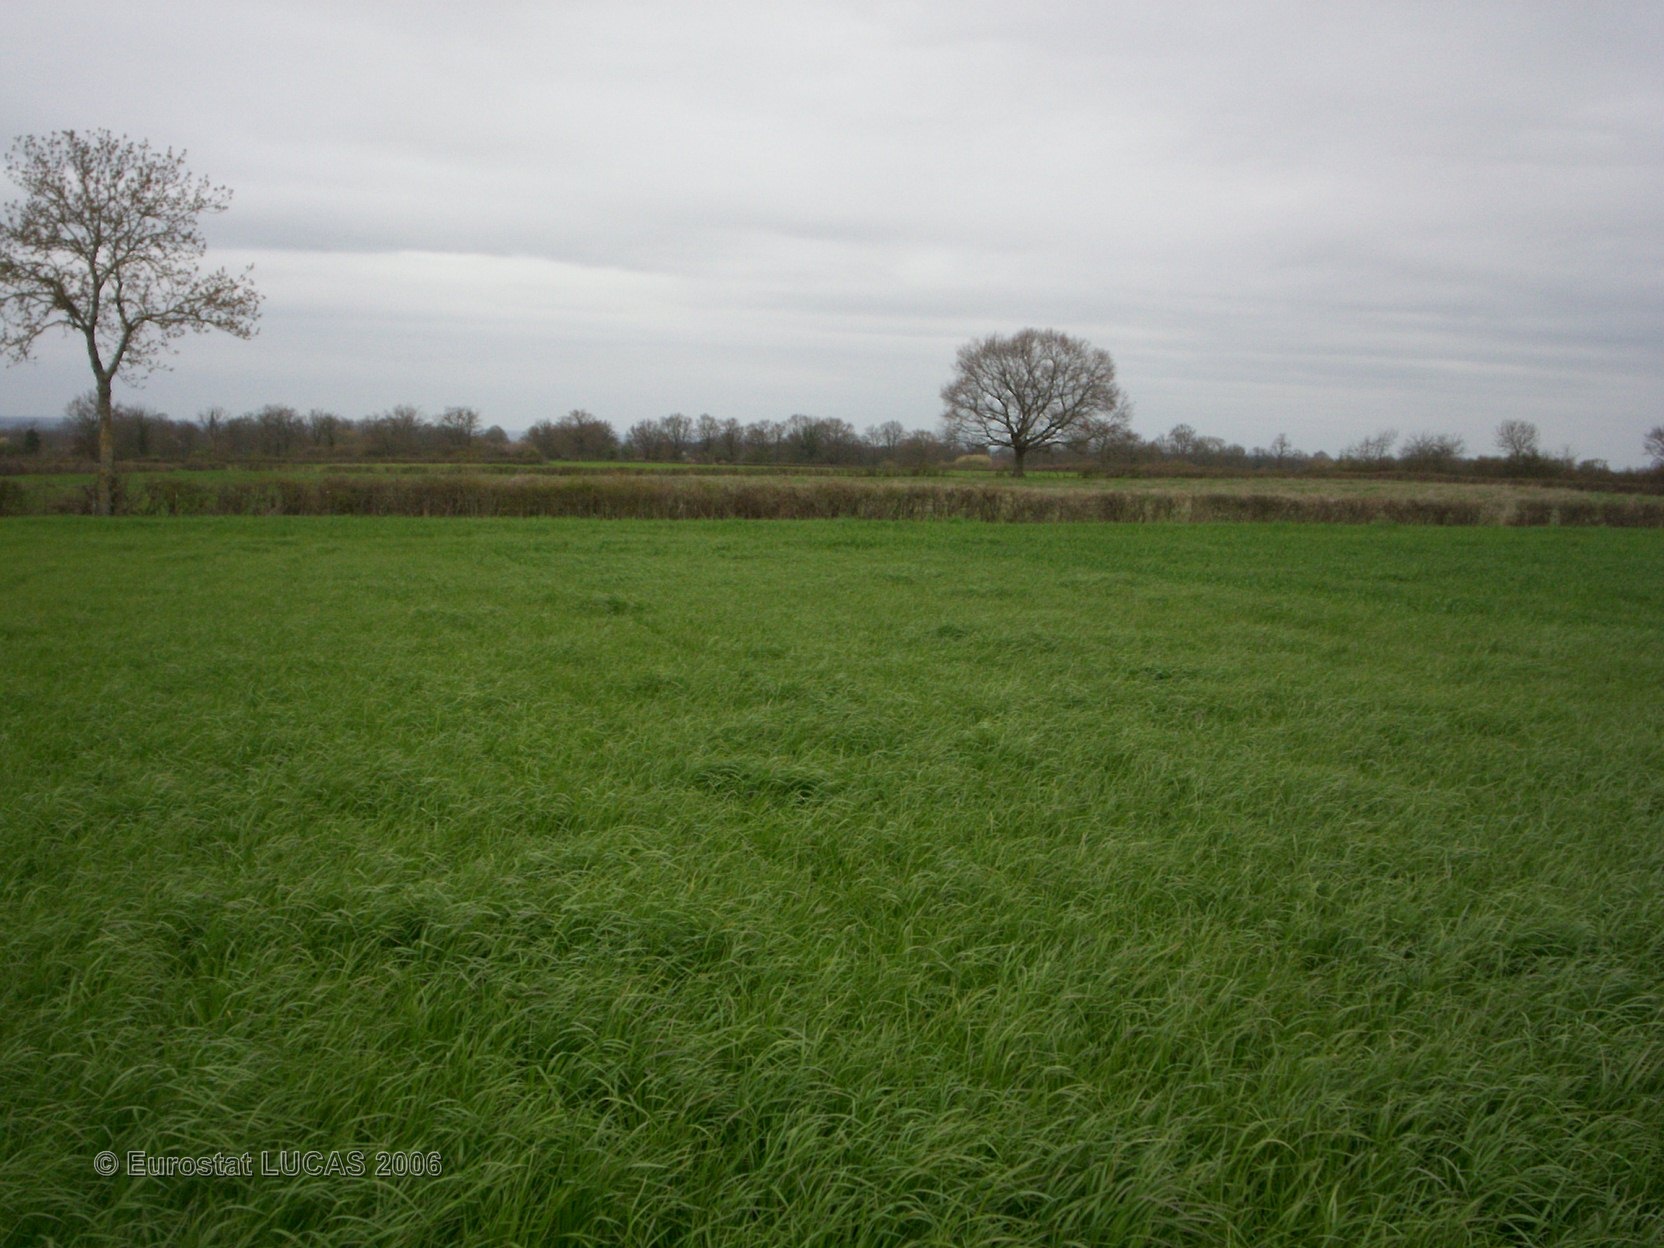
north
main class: Cropland
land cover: Barley
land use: Agriculture (excluding fallow land and kitchen gardens)
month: April
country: FR
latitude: 46.6677
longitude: 3.0564
